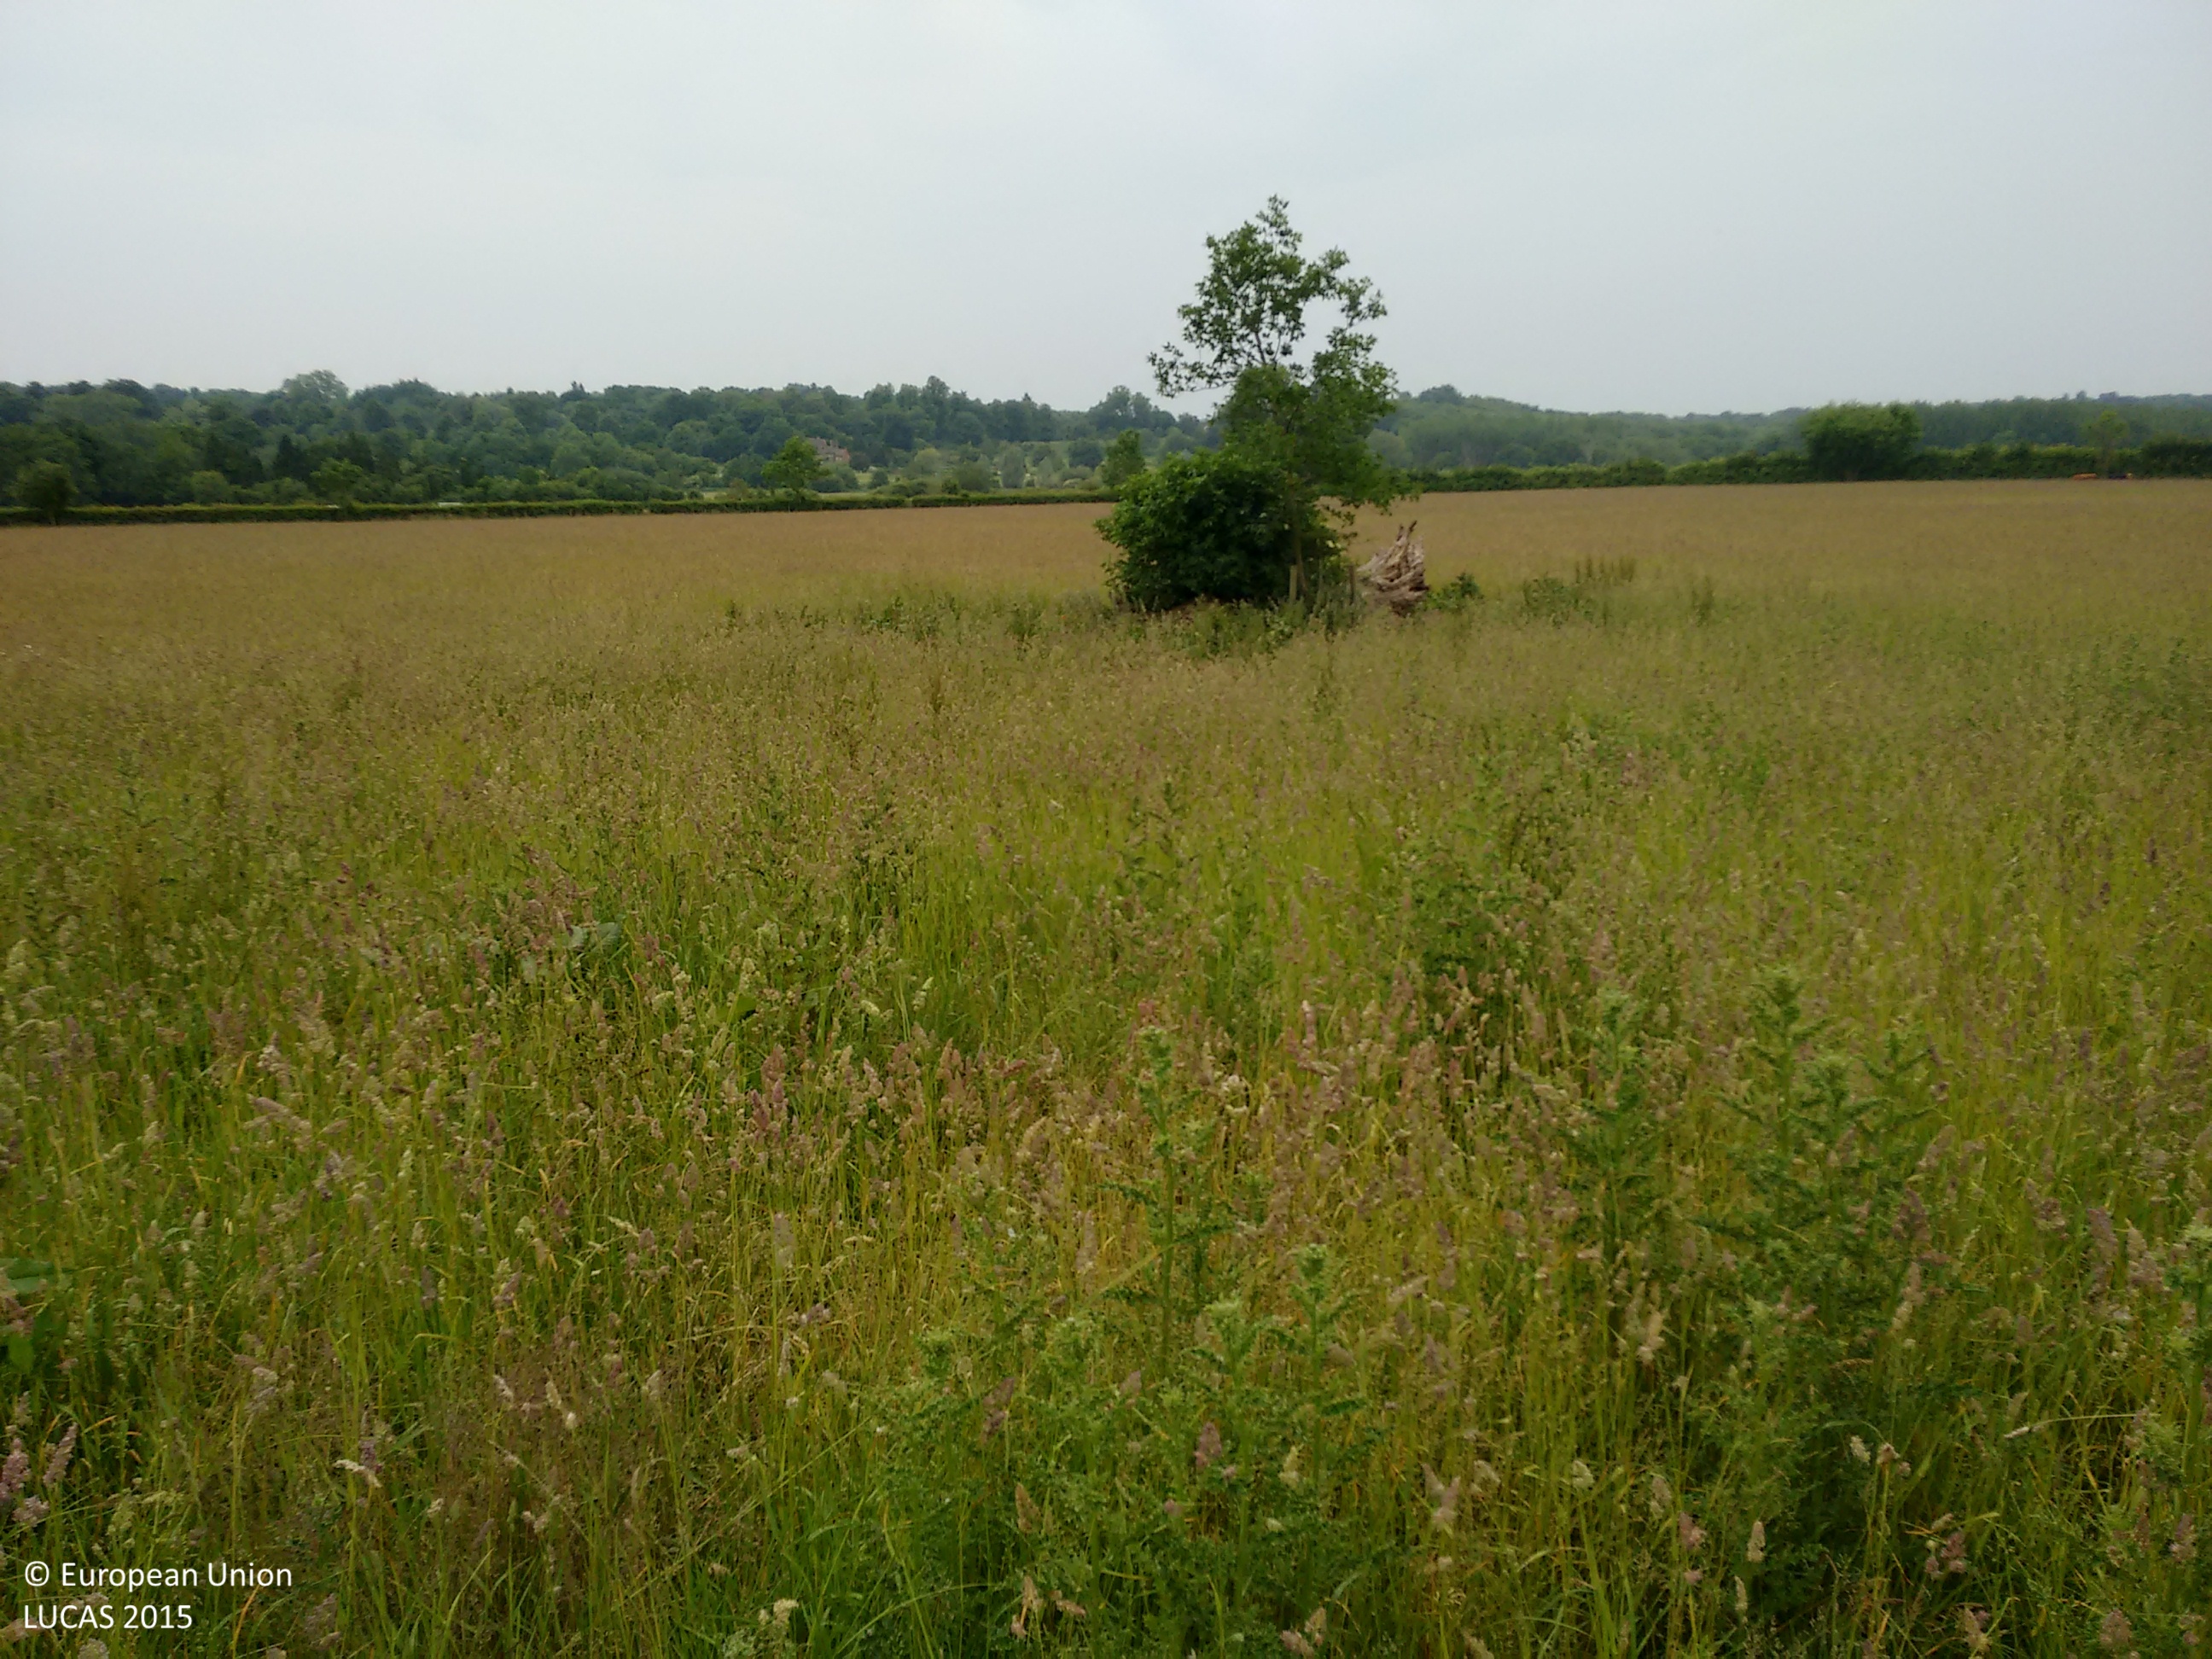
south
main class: Grassland
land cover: Grassland without tree/shrub cover
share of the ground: > 75 %
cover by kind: herbaceous plants 100 %
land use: Agriculture (excluding fallow land and kitchen gardens)
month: June
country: GB
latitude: 51.4518
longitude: -1.1412
